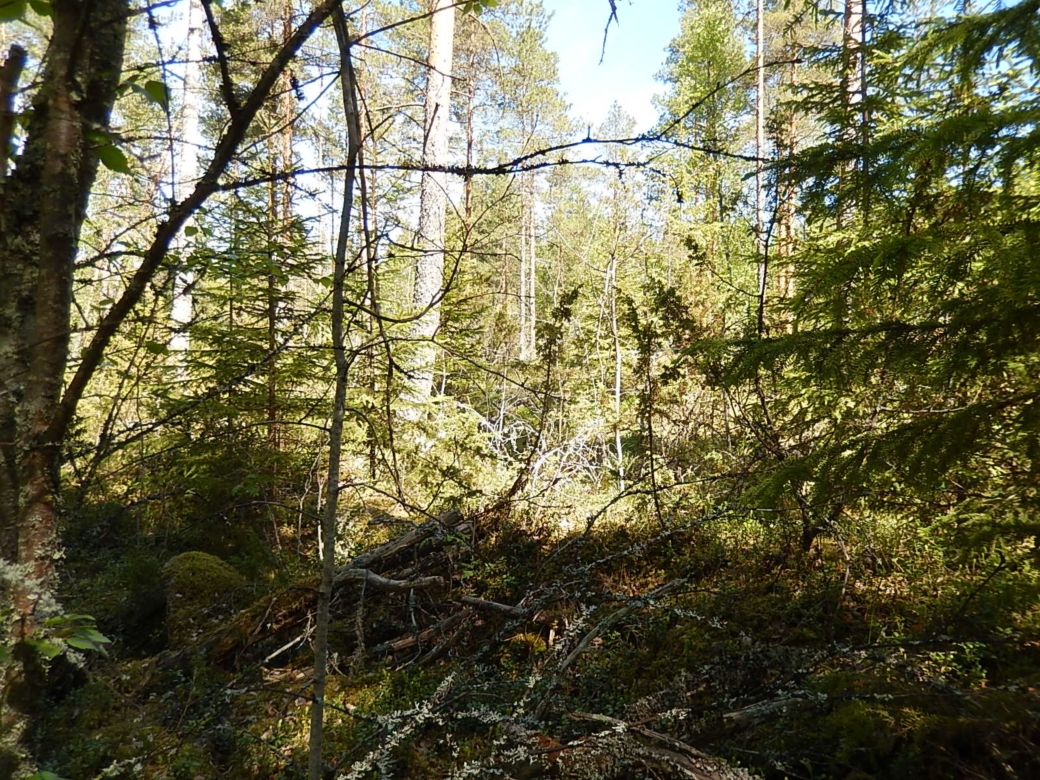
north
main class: Woodland
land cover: Pine dominated mixed woodland
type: boreal forest
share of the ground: 50 - 75 %
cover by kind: coniferous forest trees 50 %, broadleaved forest trees 20 %, shrubs 20 %, lichens and mosses 10 %
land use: Forestry
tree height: > 5 m
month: June
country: FI
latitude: 62.0751
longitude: 21.5507
